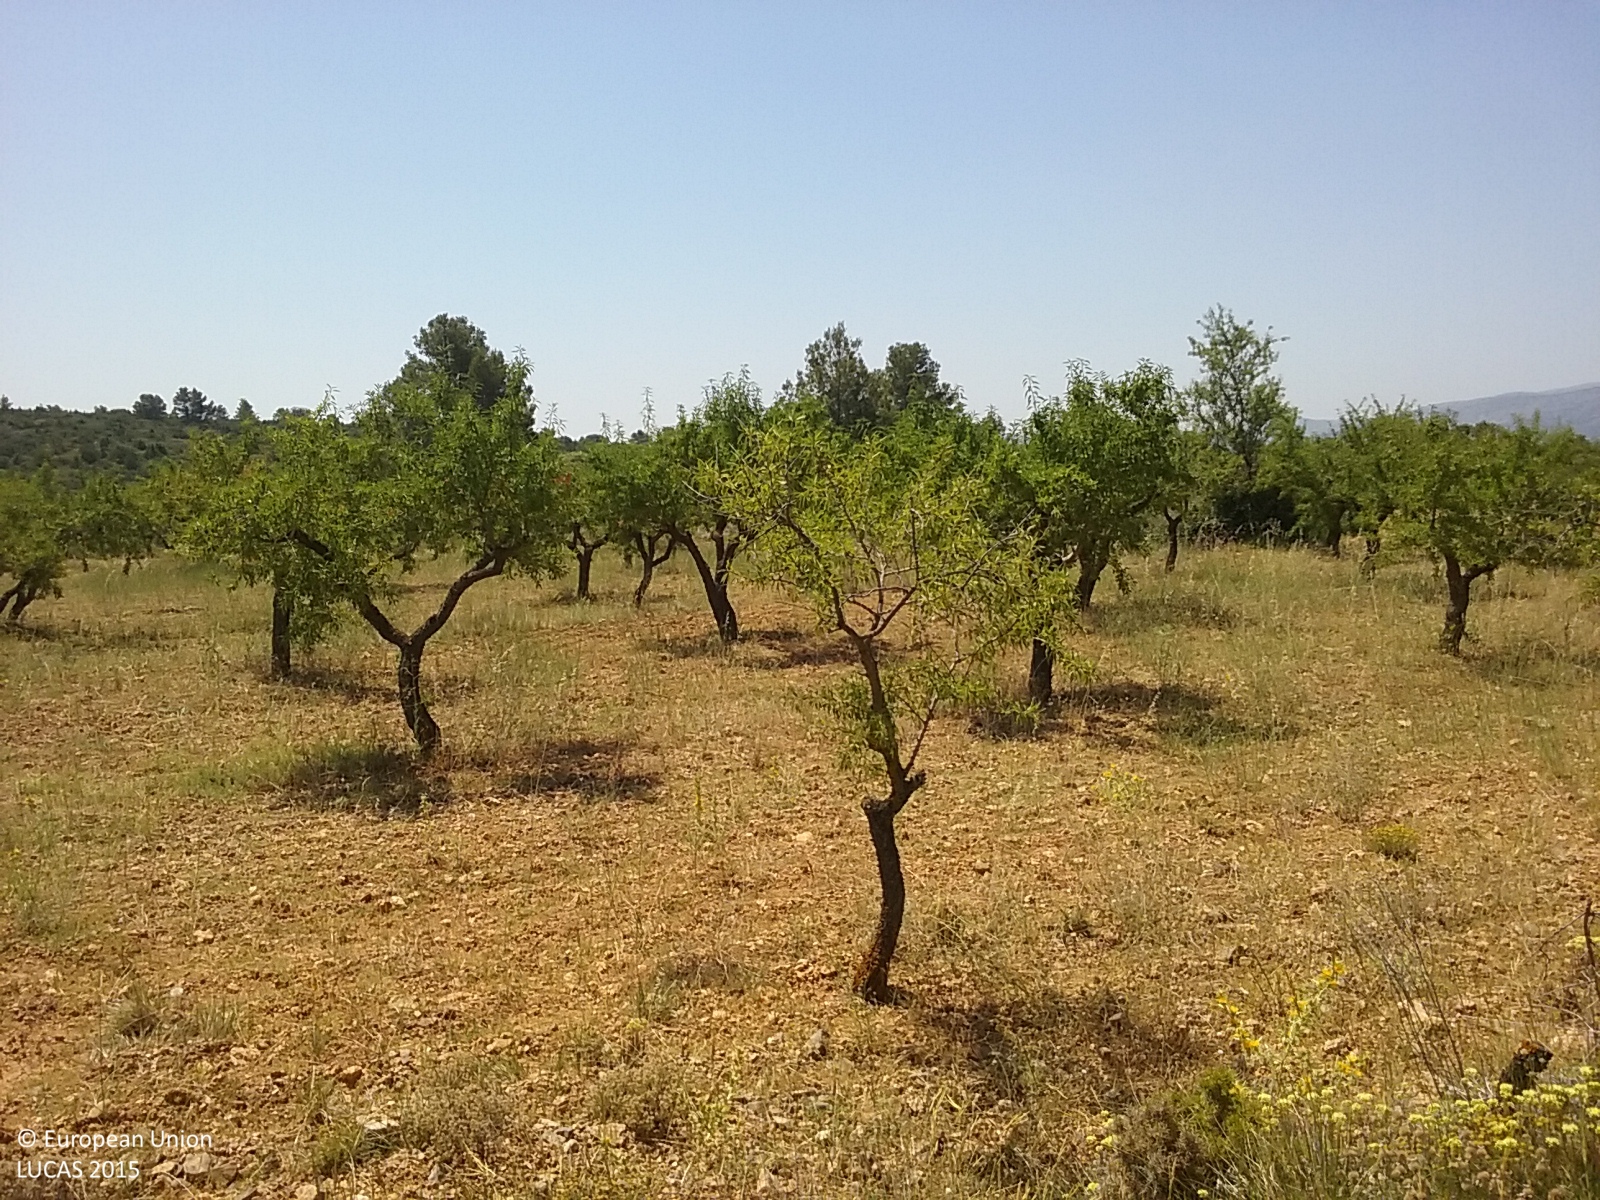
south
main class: Cropland
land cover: Nuts trees
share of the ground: 10 - 25 %
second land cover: Spontaneously vegetated surfaces
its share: 25 - 50 %
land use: Agriculture (excluding fallow land and kitchen gardens)
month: July
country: ES
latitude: 39.9371
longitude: -0.6882
